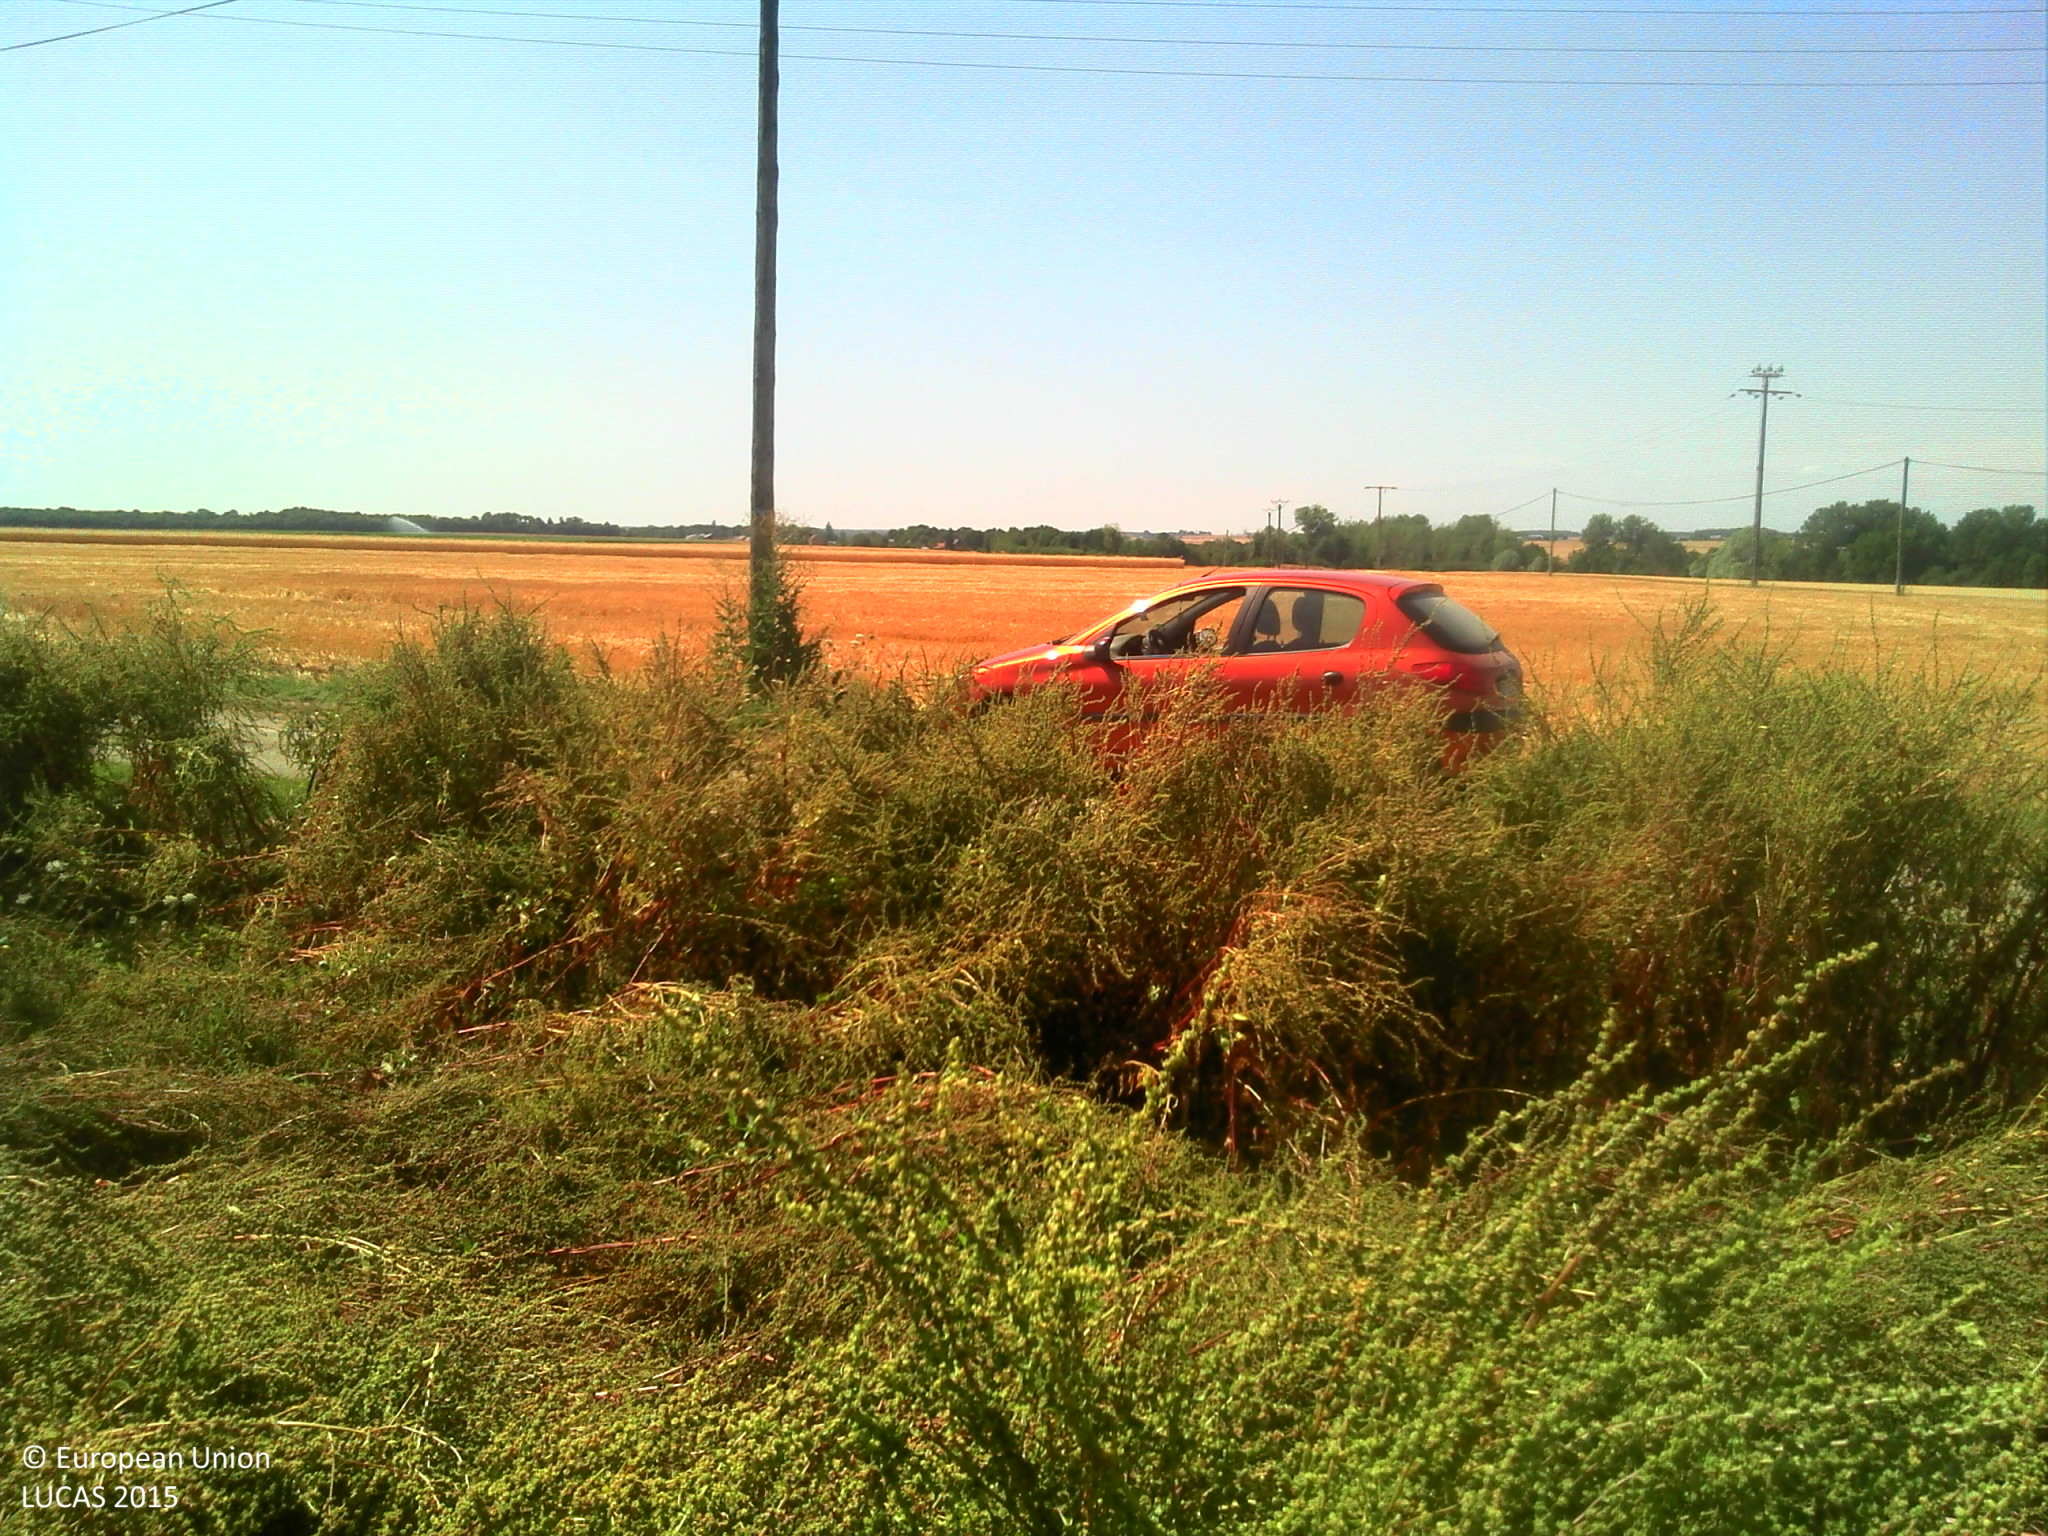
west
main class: Cropland
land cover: Sugar beet
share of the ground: > 75 %
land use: Agriculture (excluding fallow land and kitchen gardens)
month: July
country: FR
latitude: 48.2030
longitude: 1.2767
